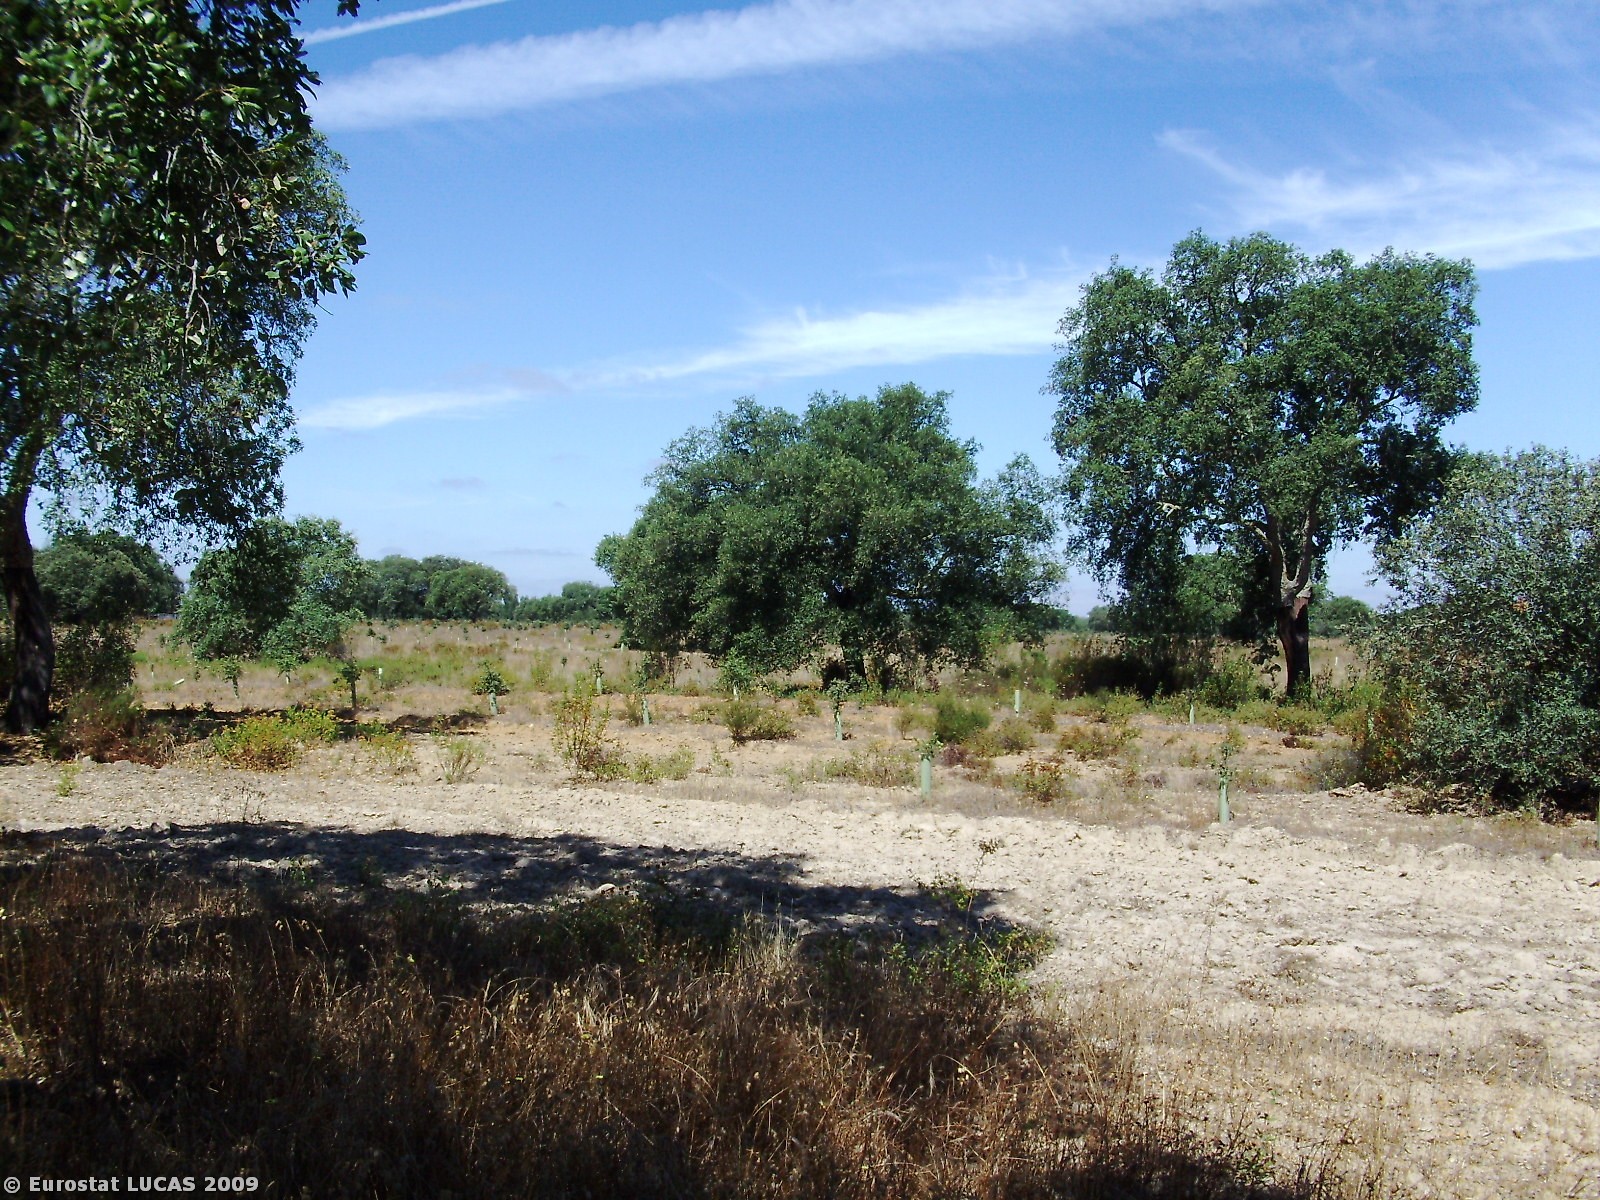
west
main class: Woodland
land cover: Broadleaved woodland
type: broadleaved evergreen forest
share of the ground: 25 - 50 %
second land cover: Spontaneously vegetated surfaces
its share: 25 - 50 %
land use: Forestry
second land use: Fallow land
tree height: > 5 m
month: July
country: PT
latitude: 37.7886
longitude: -8.3977
